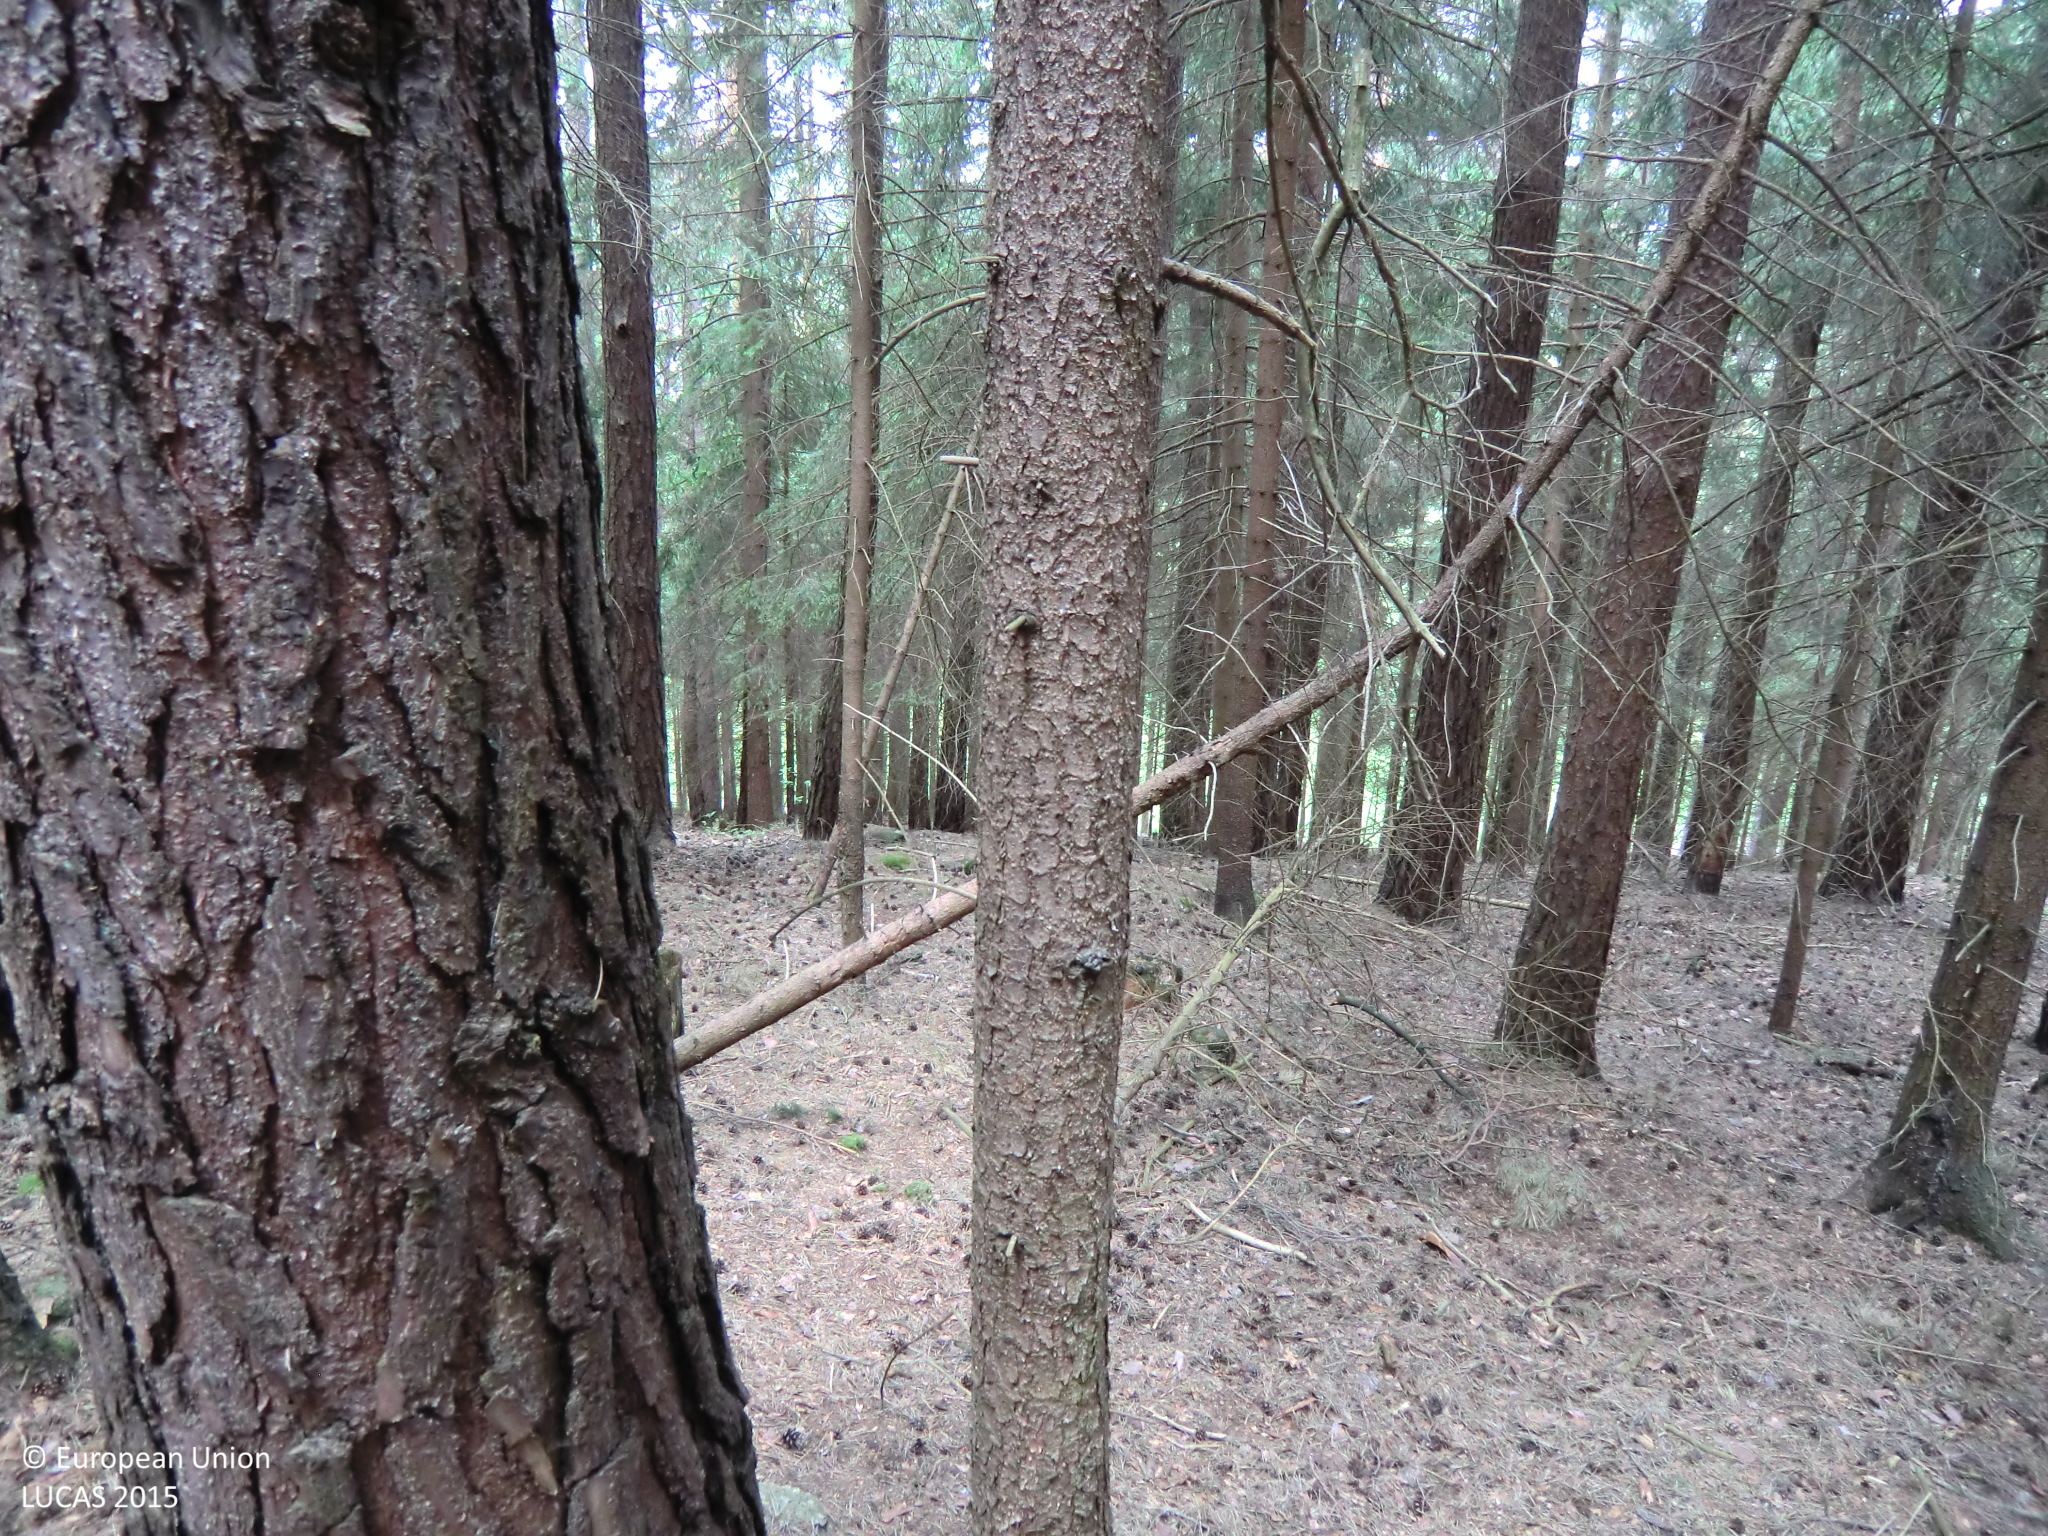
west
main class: Woodland
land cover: Pine dominated coniferous woodland
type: hemiboreal forest and nemoral coniferous forest and mixed broadleaved-coniferous forest
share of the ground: > 75 %
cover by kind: coniferous forest trees 90 %, unconsolidated bare surface 10 %
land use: Forestry
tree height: > 5 m
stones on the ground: < 10 %
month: June
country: AT
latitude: 48.6121
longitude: 15.0611
